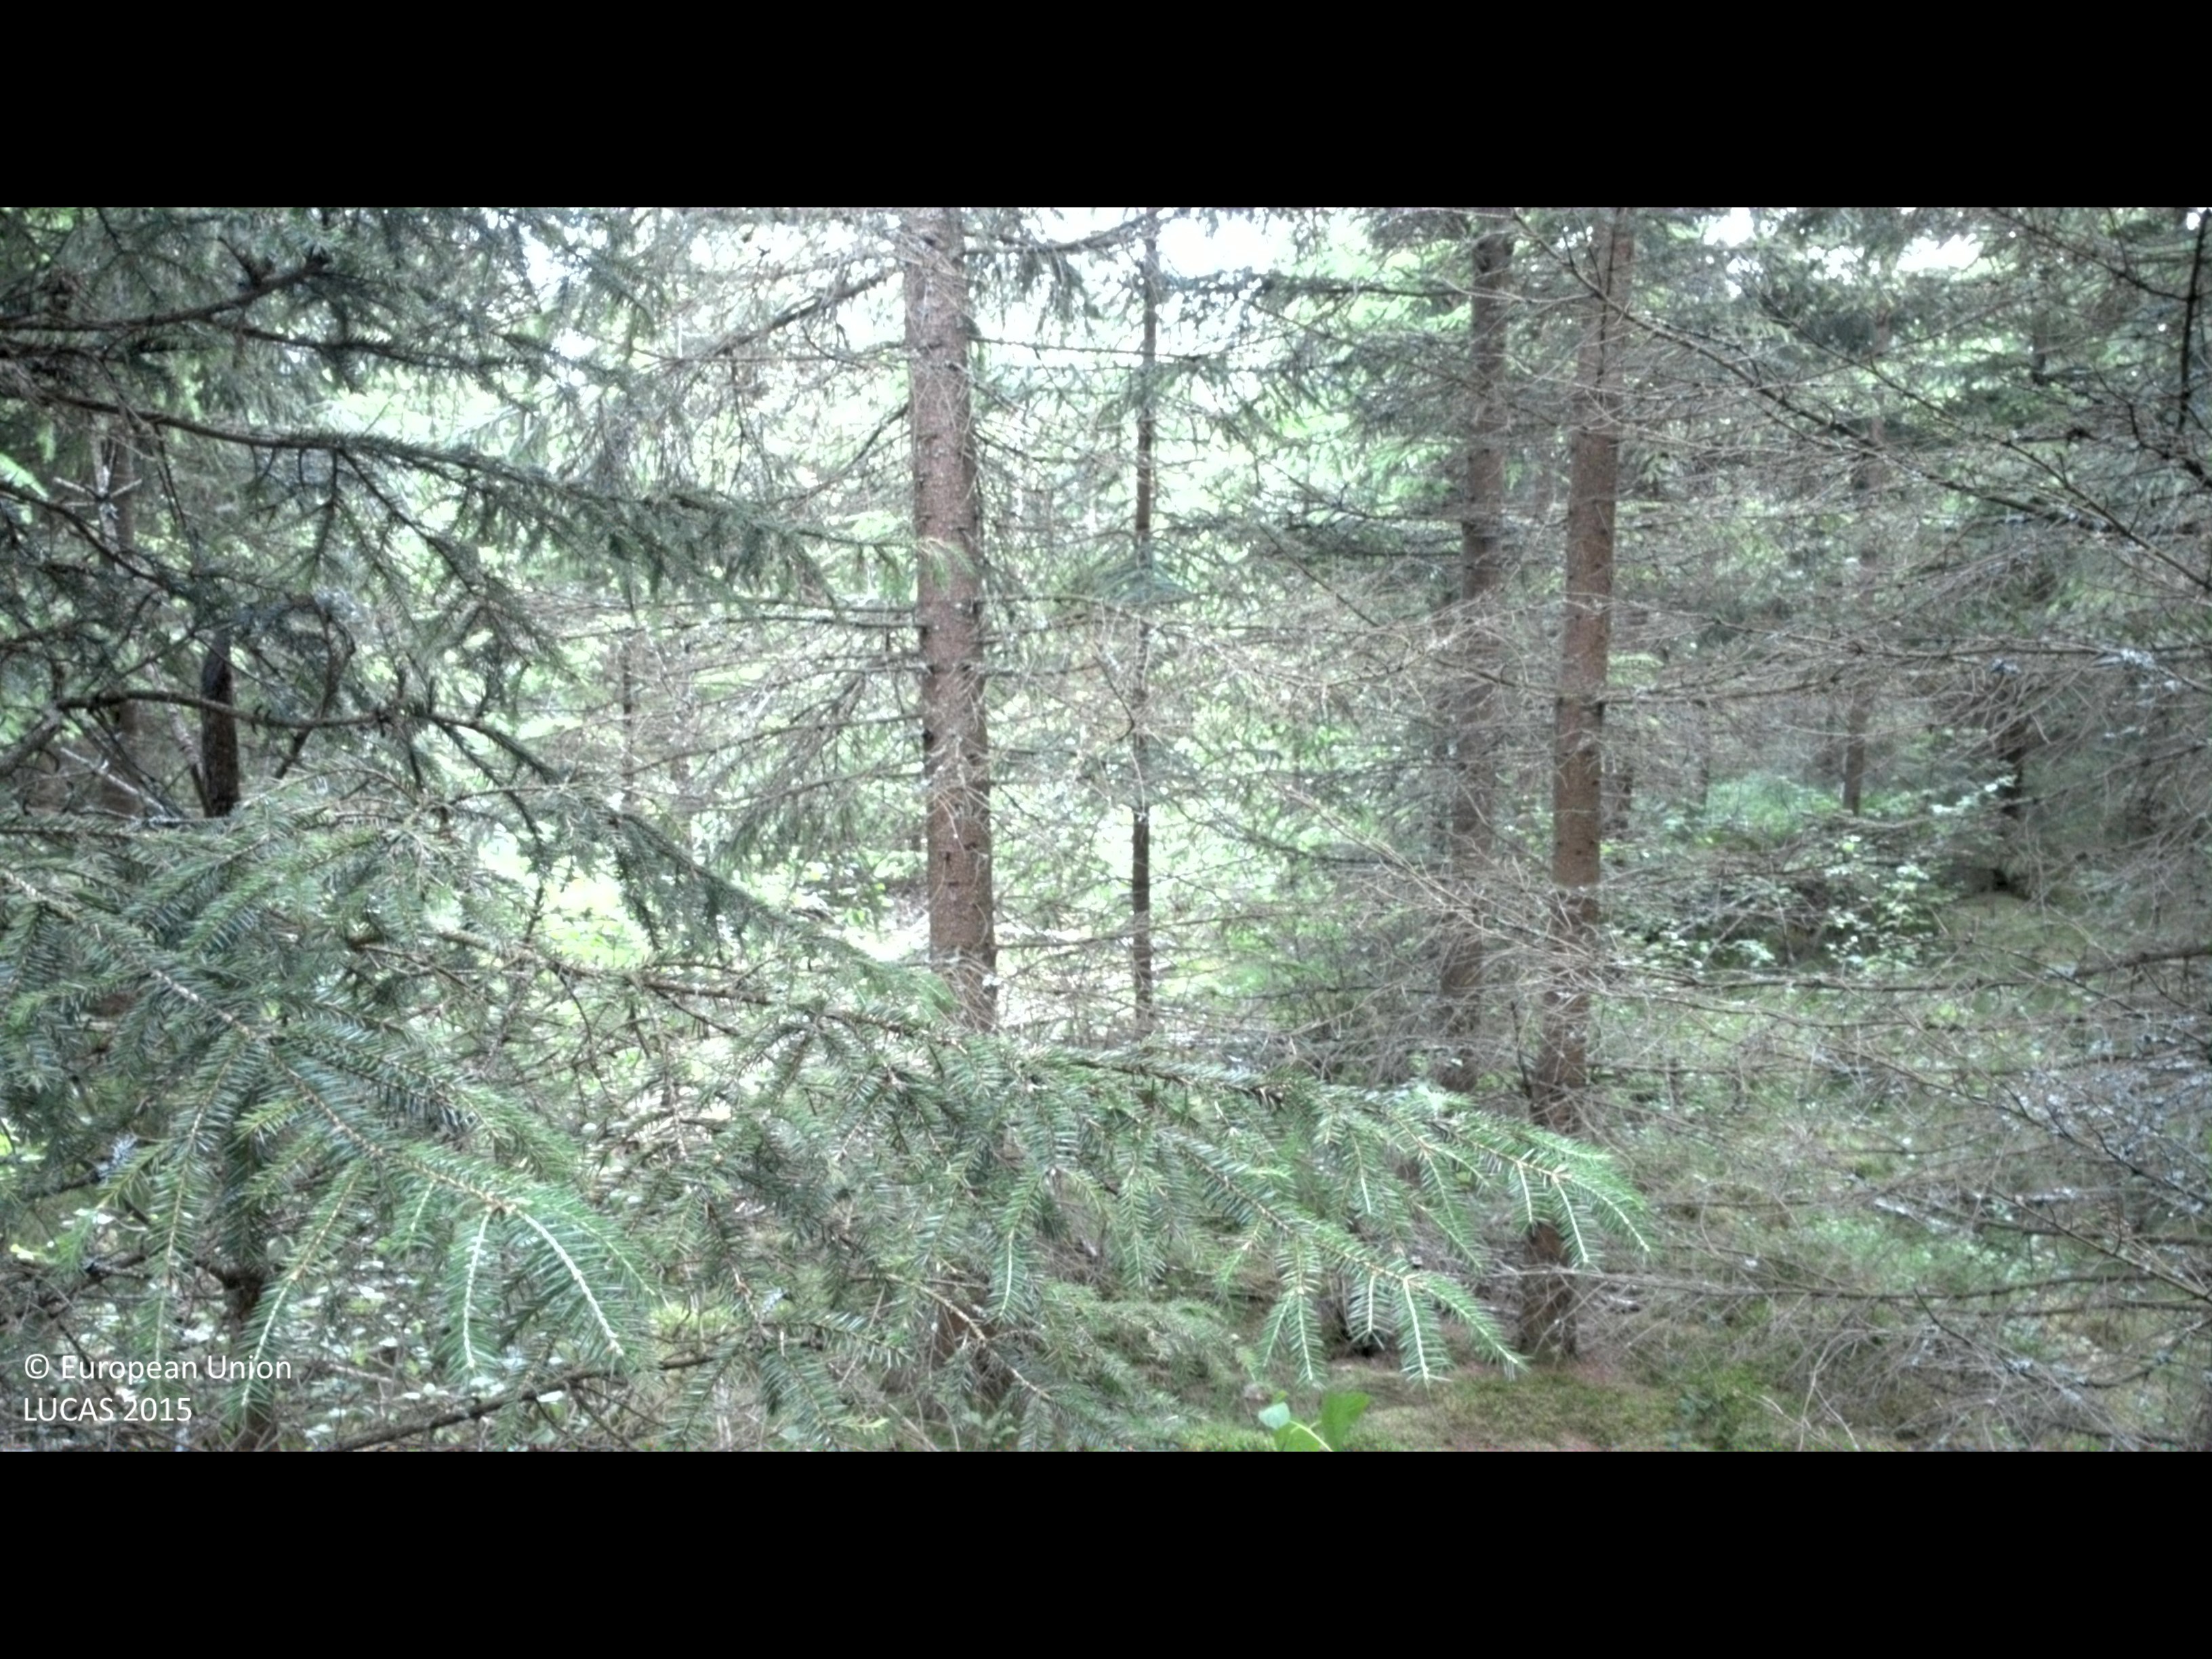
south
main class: Woodland
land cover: Spruce dominated mixed woodland
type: boreal forest
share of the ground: > 75 %
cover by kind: coniferous forest trees 60 %, broadleaved forest trees 20 %, shrubs 20 %
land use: Forestry
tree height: > 5 m
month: July
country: SE
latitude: 56.4911
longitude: 13.8138
